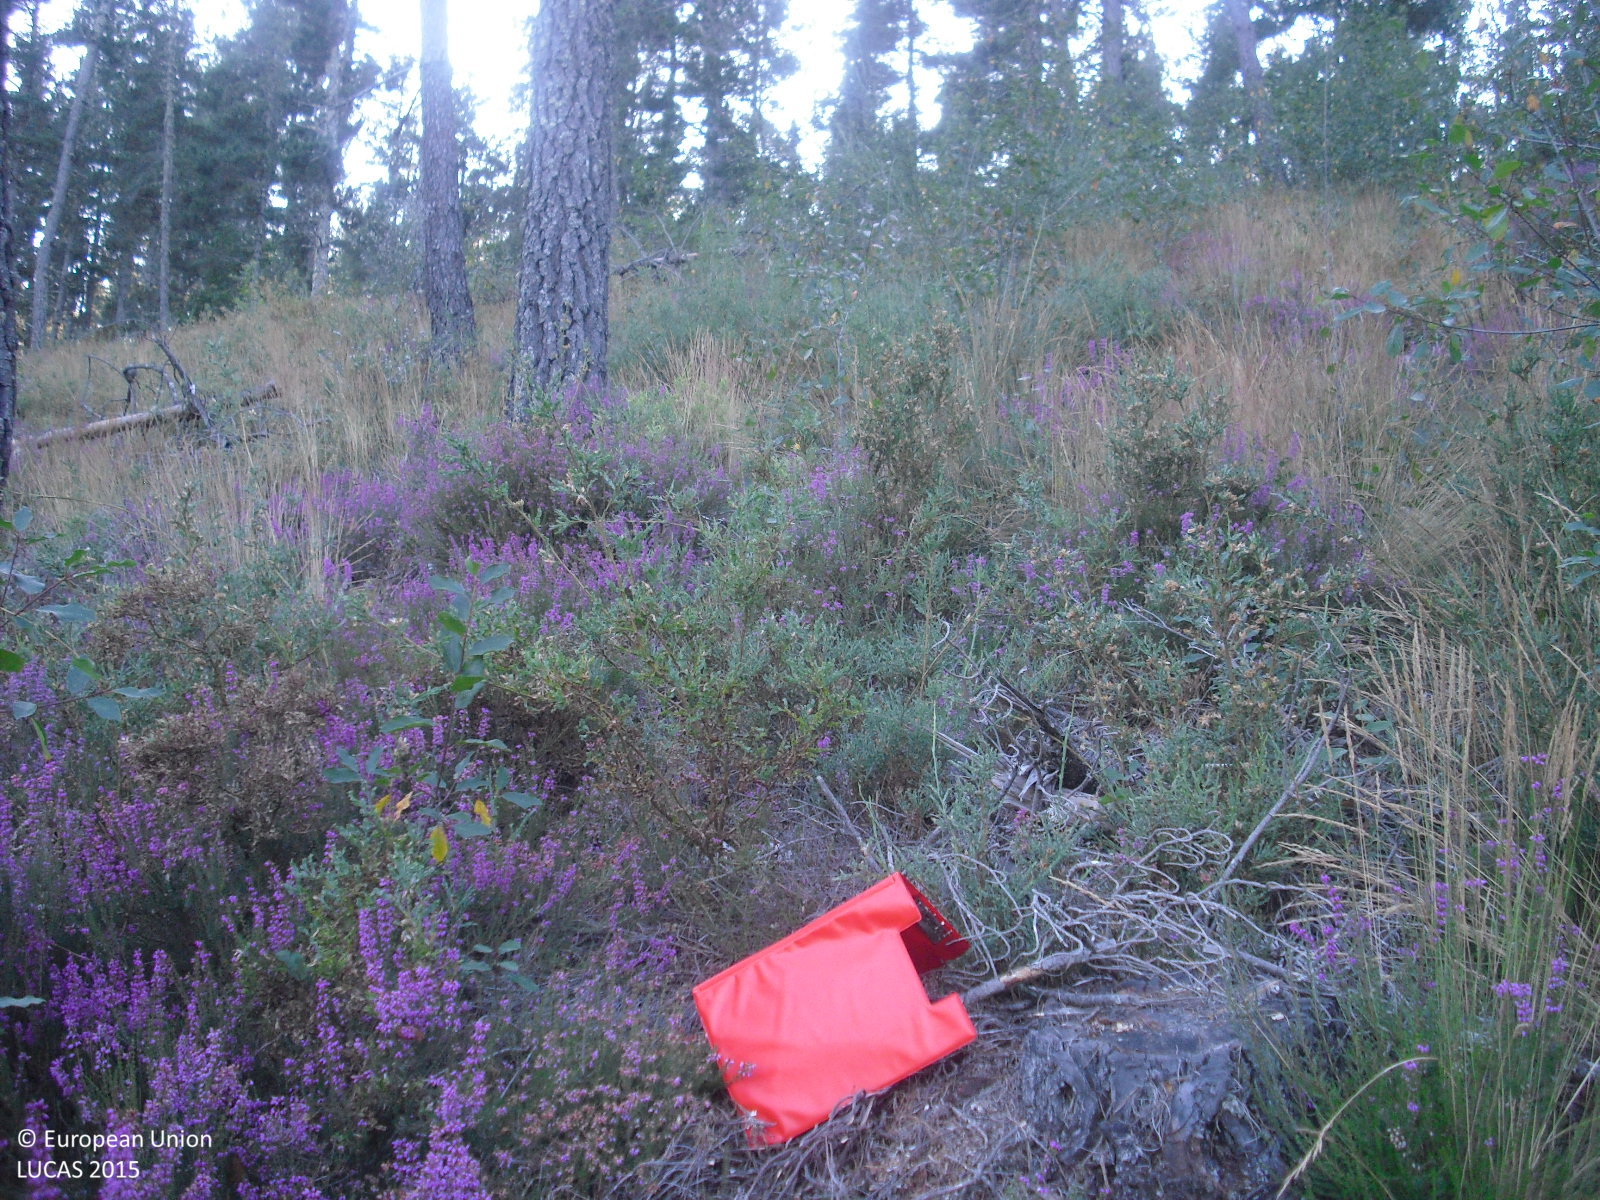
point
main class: Woodland
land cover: Pine dominated coniferous woodland
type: hemiboreal forest and nemoral coniferous forest and mixed broadleaved-coniferous forest
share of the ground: 25 - 50 %
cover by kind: shrubs 70 %, coniferous forest trees 30 %
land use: Forestry
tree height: > 5 m
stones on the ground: 25 - 50 %
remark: Clear cut
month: July
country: ES
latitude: 42.5703
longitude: -7.3025
